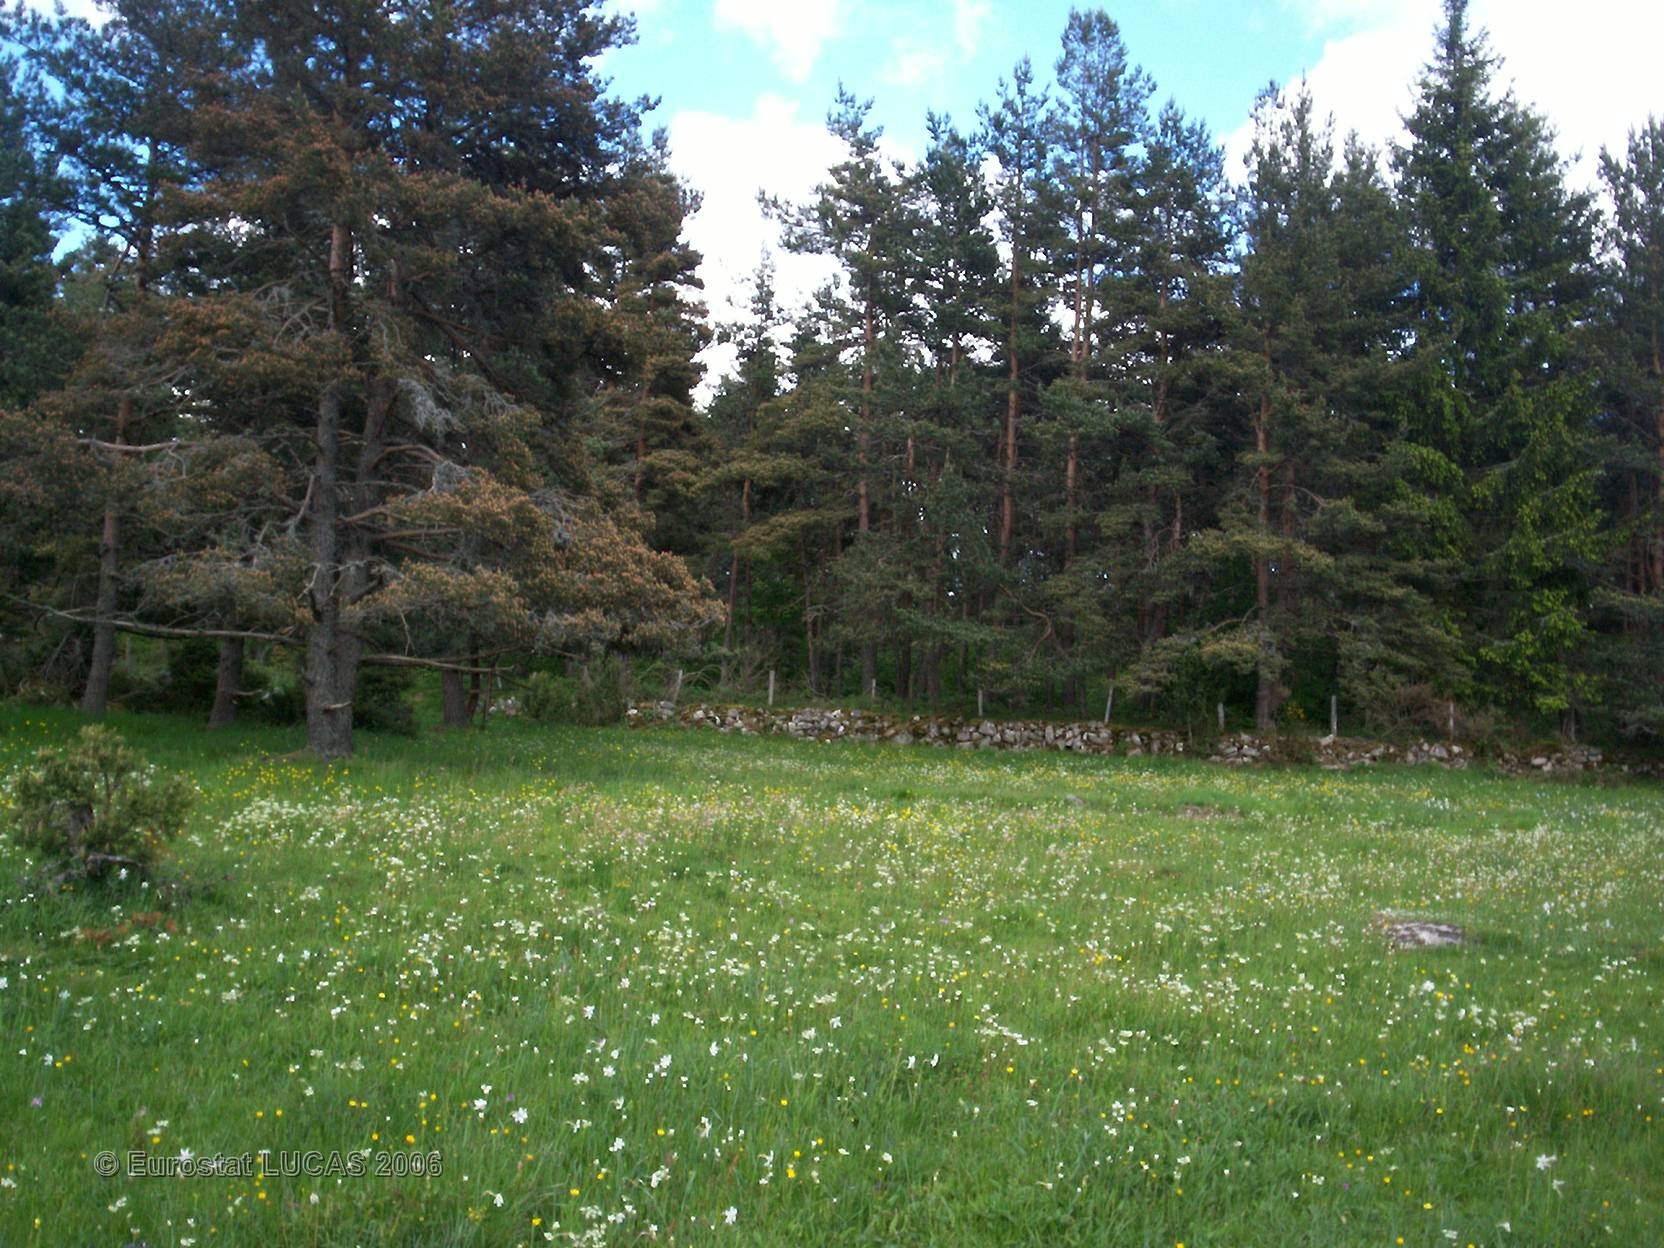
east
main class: Grassland
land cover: Grassland without tree/shrub cover
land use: Agriculture (excluding fallow land and kitchen gardens)
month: May
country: FR
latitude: 44.6295
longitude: 3.4122
